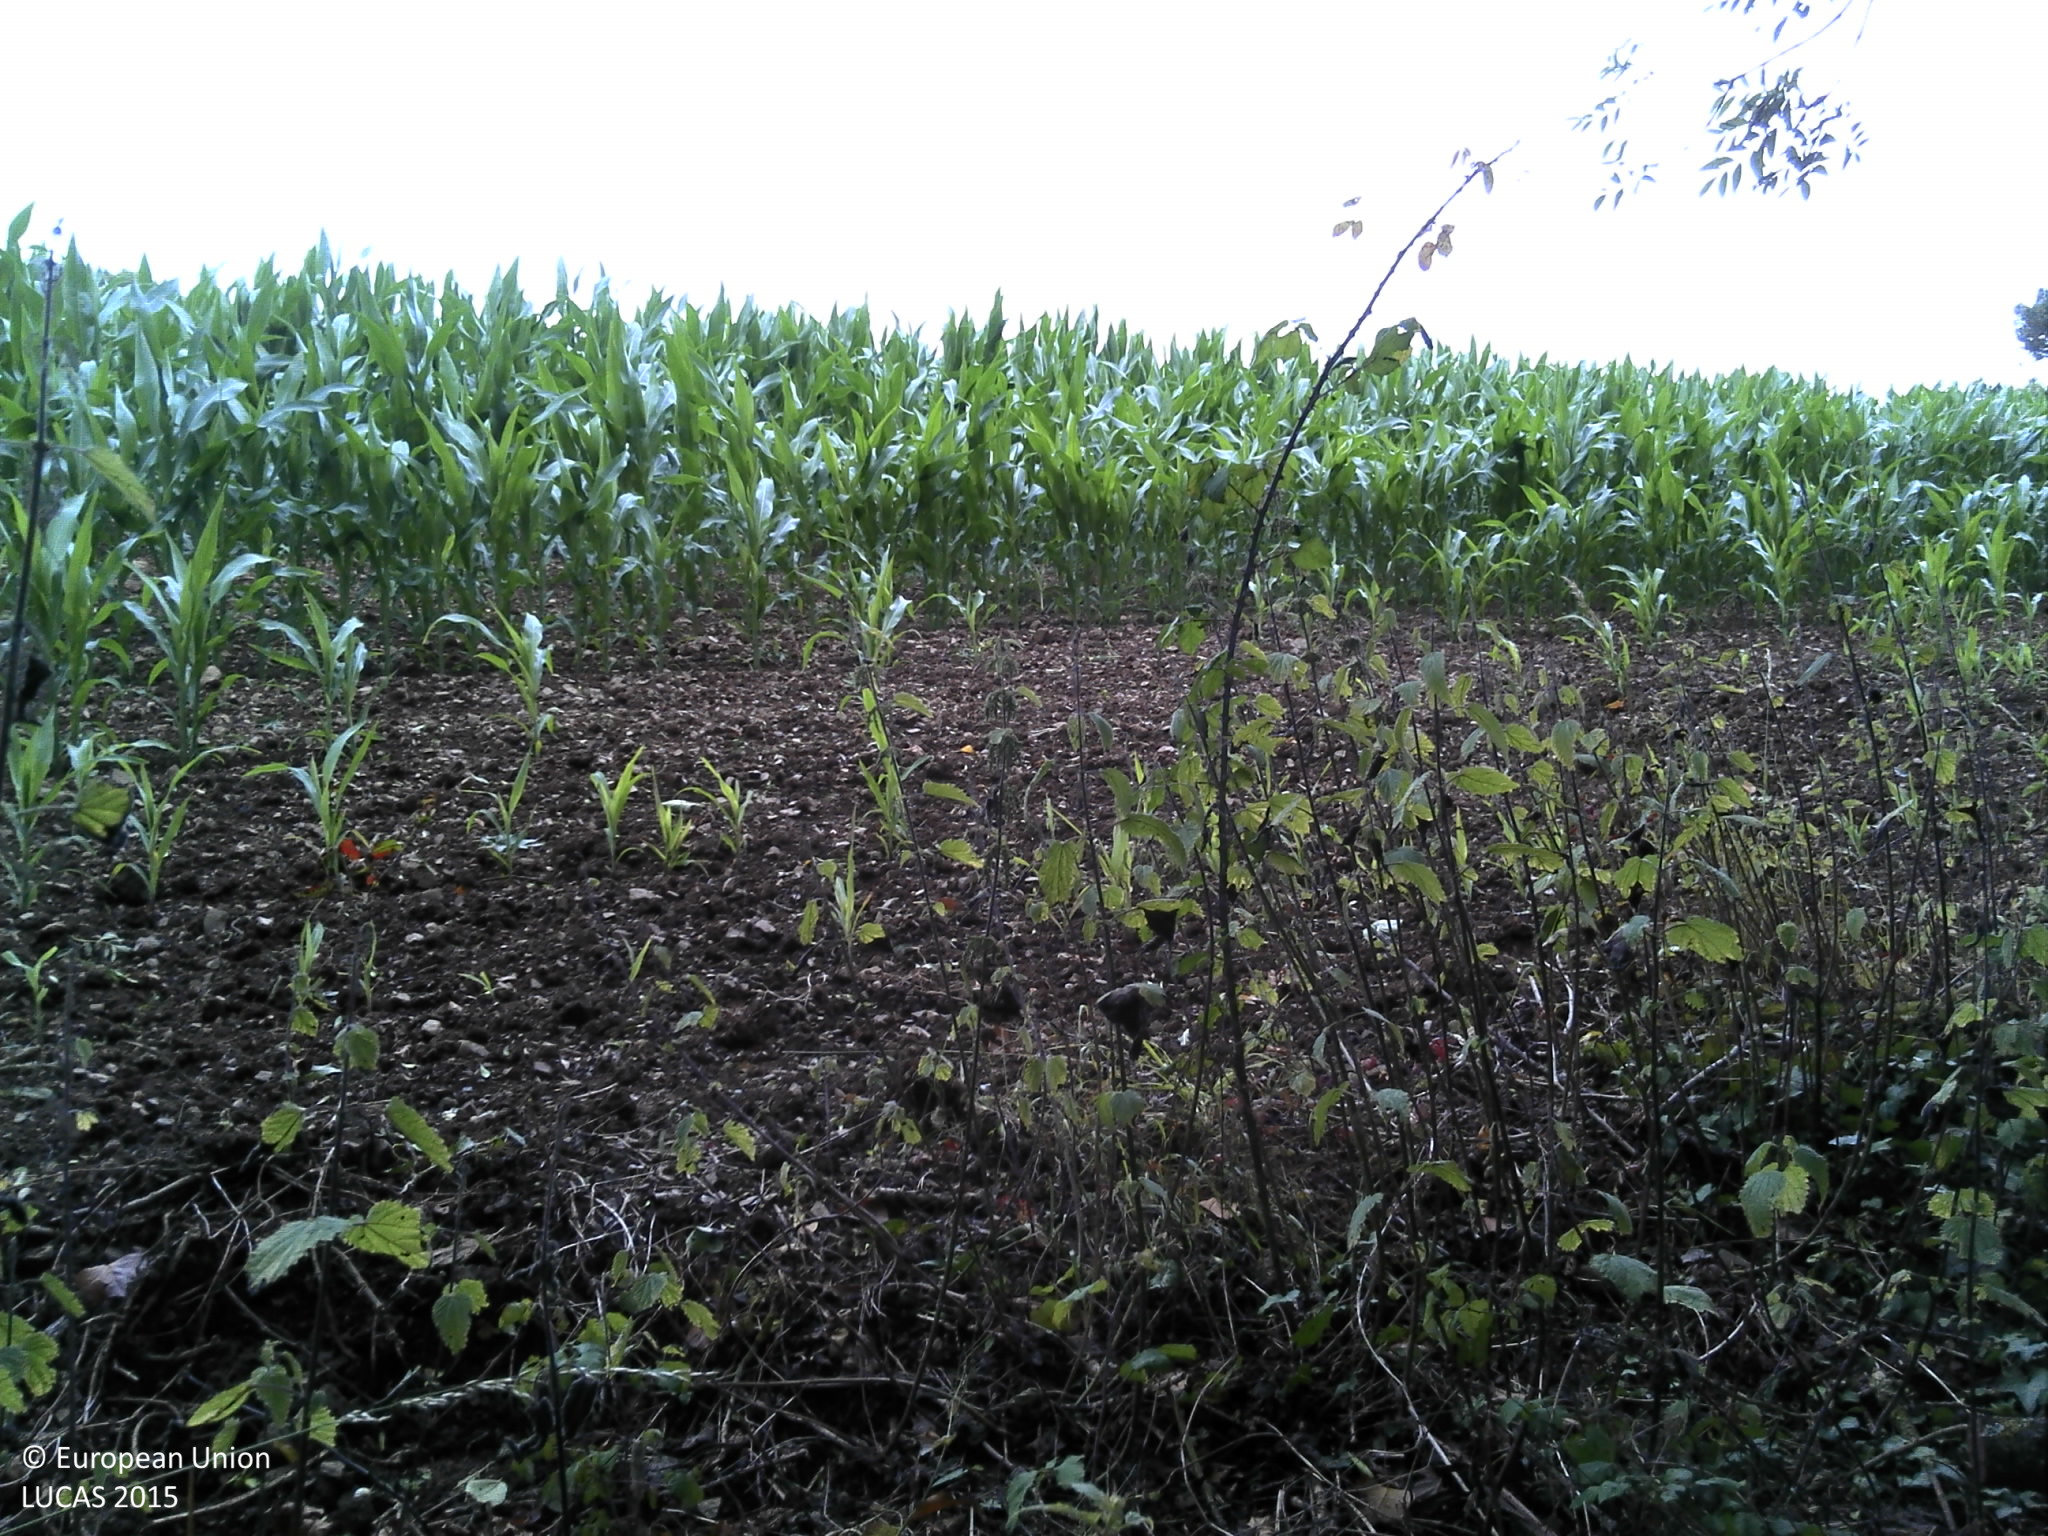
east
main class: Woodland
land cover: Broadleaved woodland
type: mesophytic deciduous forest
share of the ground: > 75 %
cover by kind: broadleaved forest trees 100 %
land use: Agriculture (excluding fallow land and kitchen gardens)
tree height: > 5 m
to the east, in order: Broadleaved woodland; Maize; Electric lines; Maize; Broadleaved woodland; Paved roads, cycling and walking lanes; Electric lines; Broadleaved woodland; Apple fruit; Broadleaved woodland; Common wheat
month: July
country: FR
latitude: 48.2846
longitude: -4.2019
